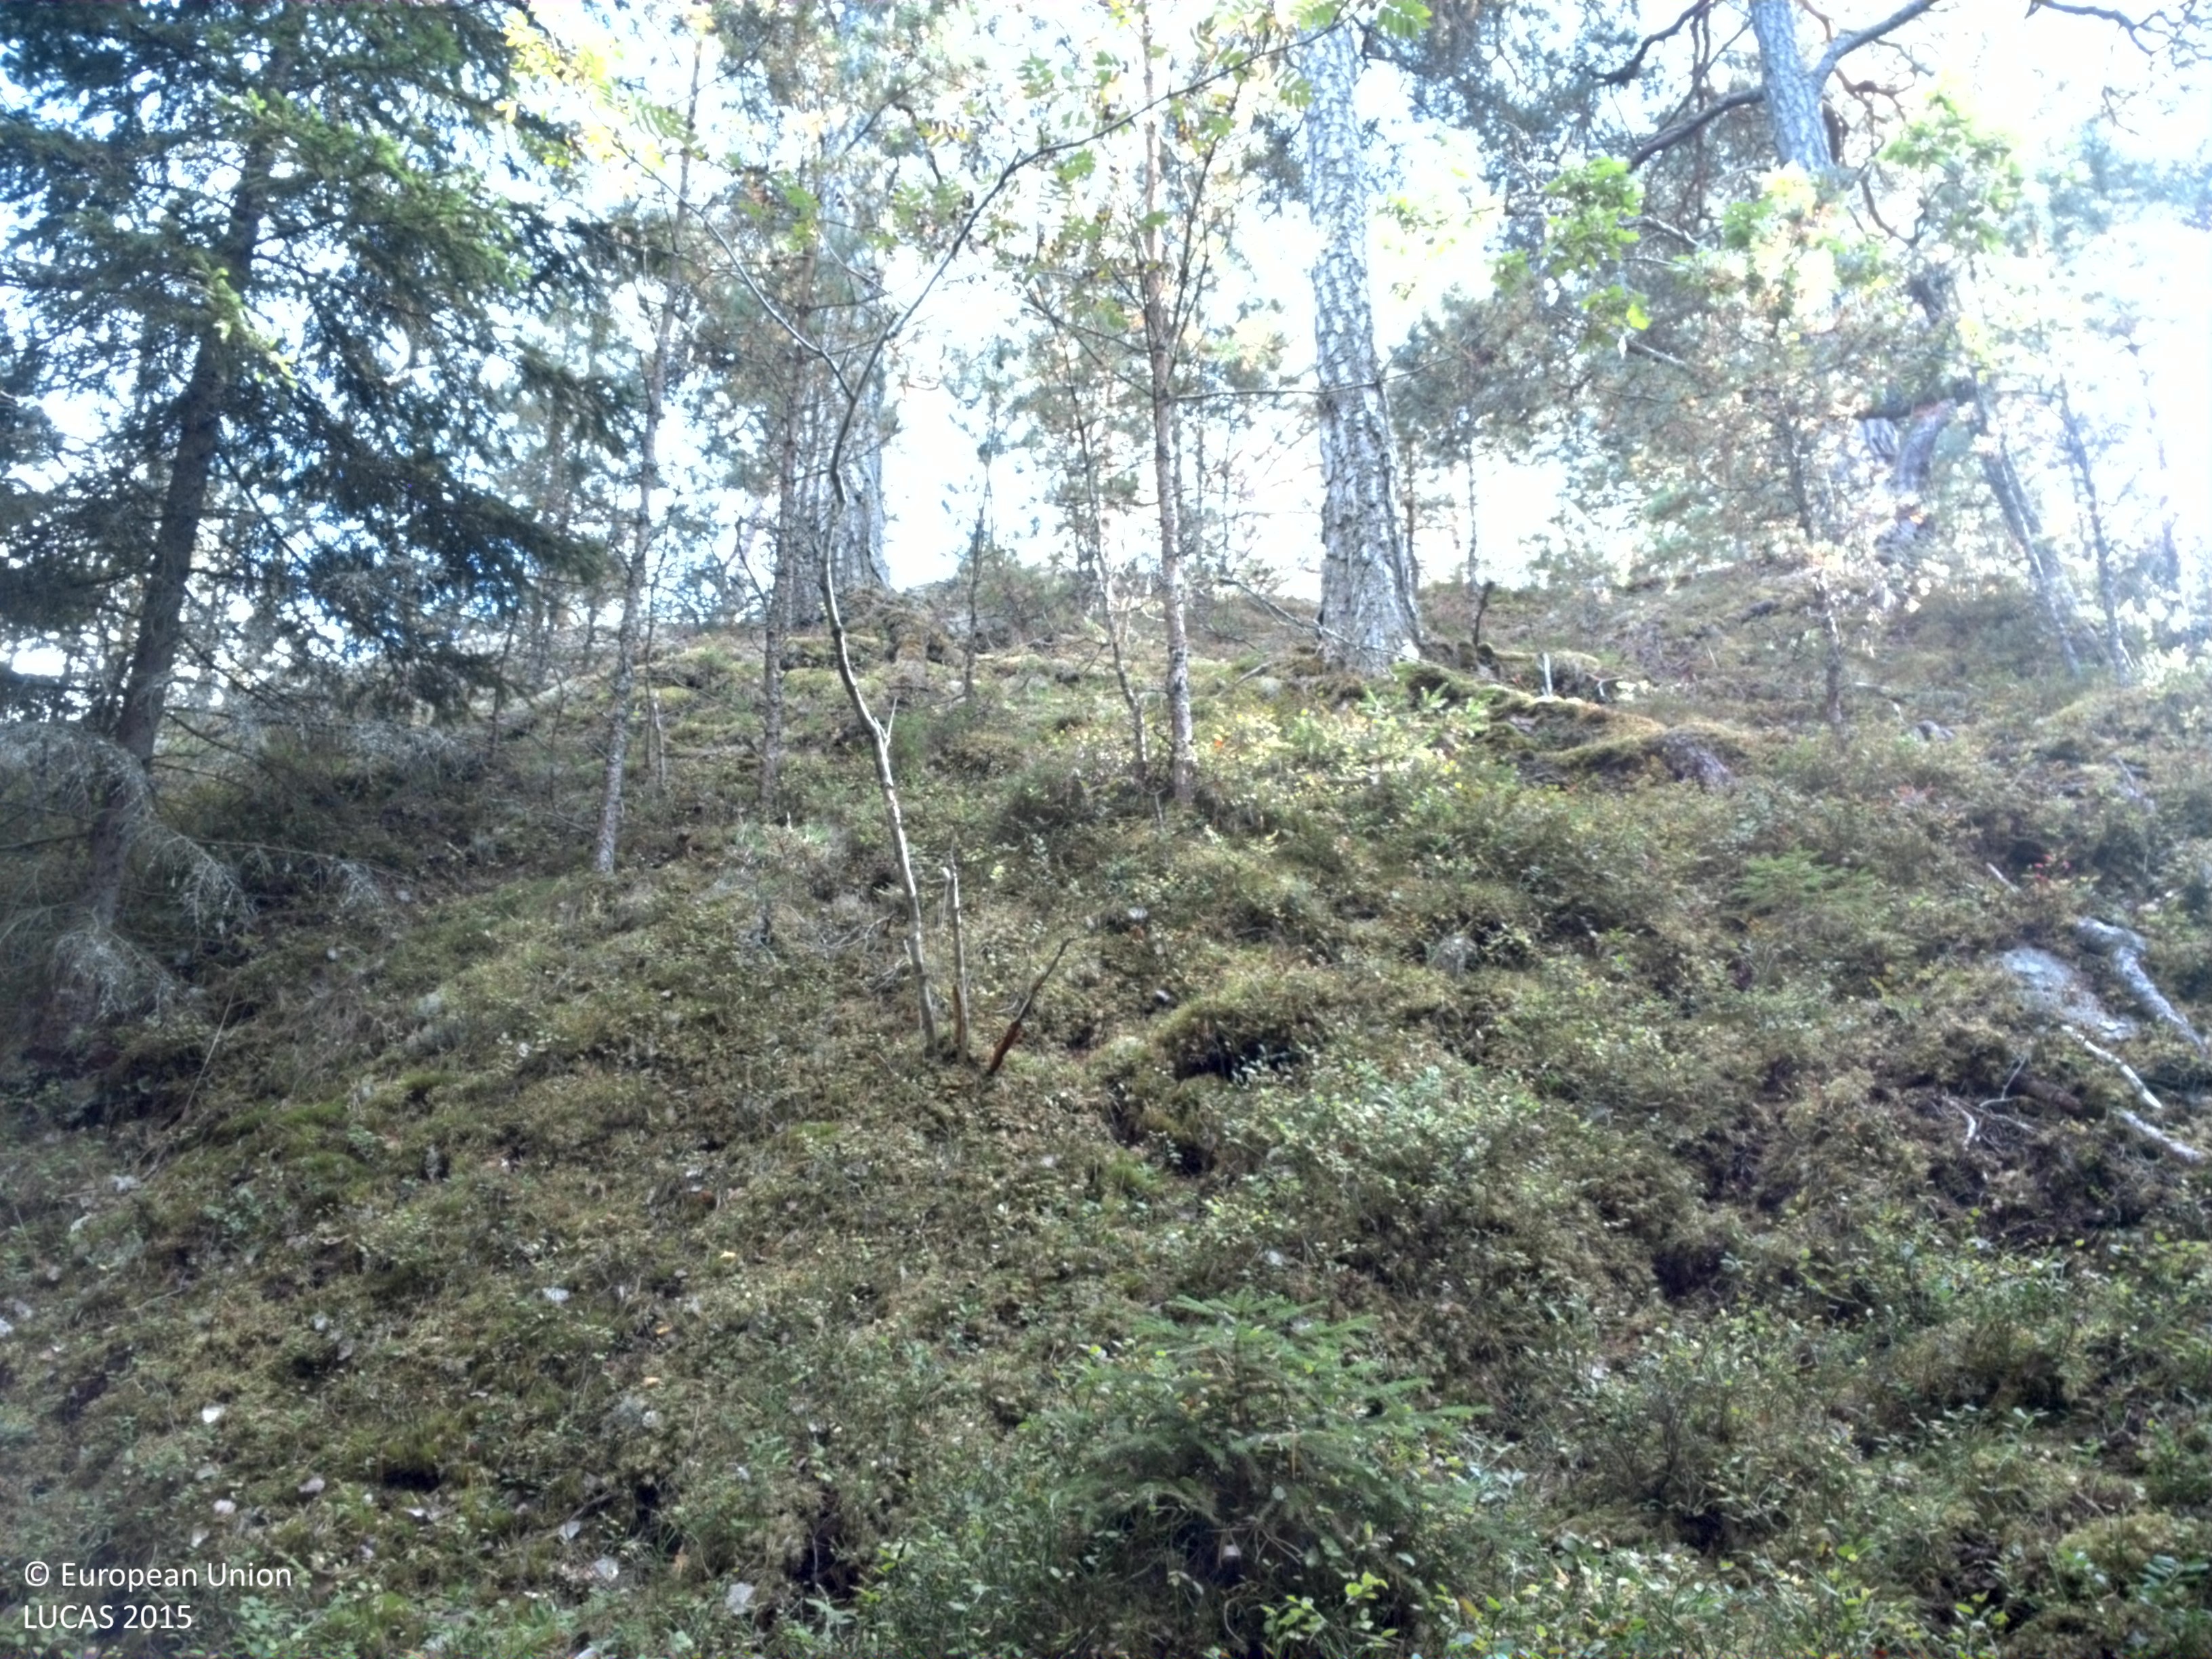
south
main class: Woodland
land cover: Pine dominated coniferous woodland
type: boreal forest
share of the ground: 50 - 75 %
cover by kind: coniferous forest trees 65 %, lichens and mosses 35 %
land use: Forestry
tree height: > 5 m
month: September
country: SE
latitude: 59.3781
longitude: 18.5373
